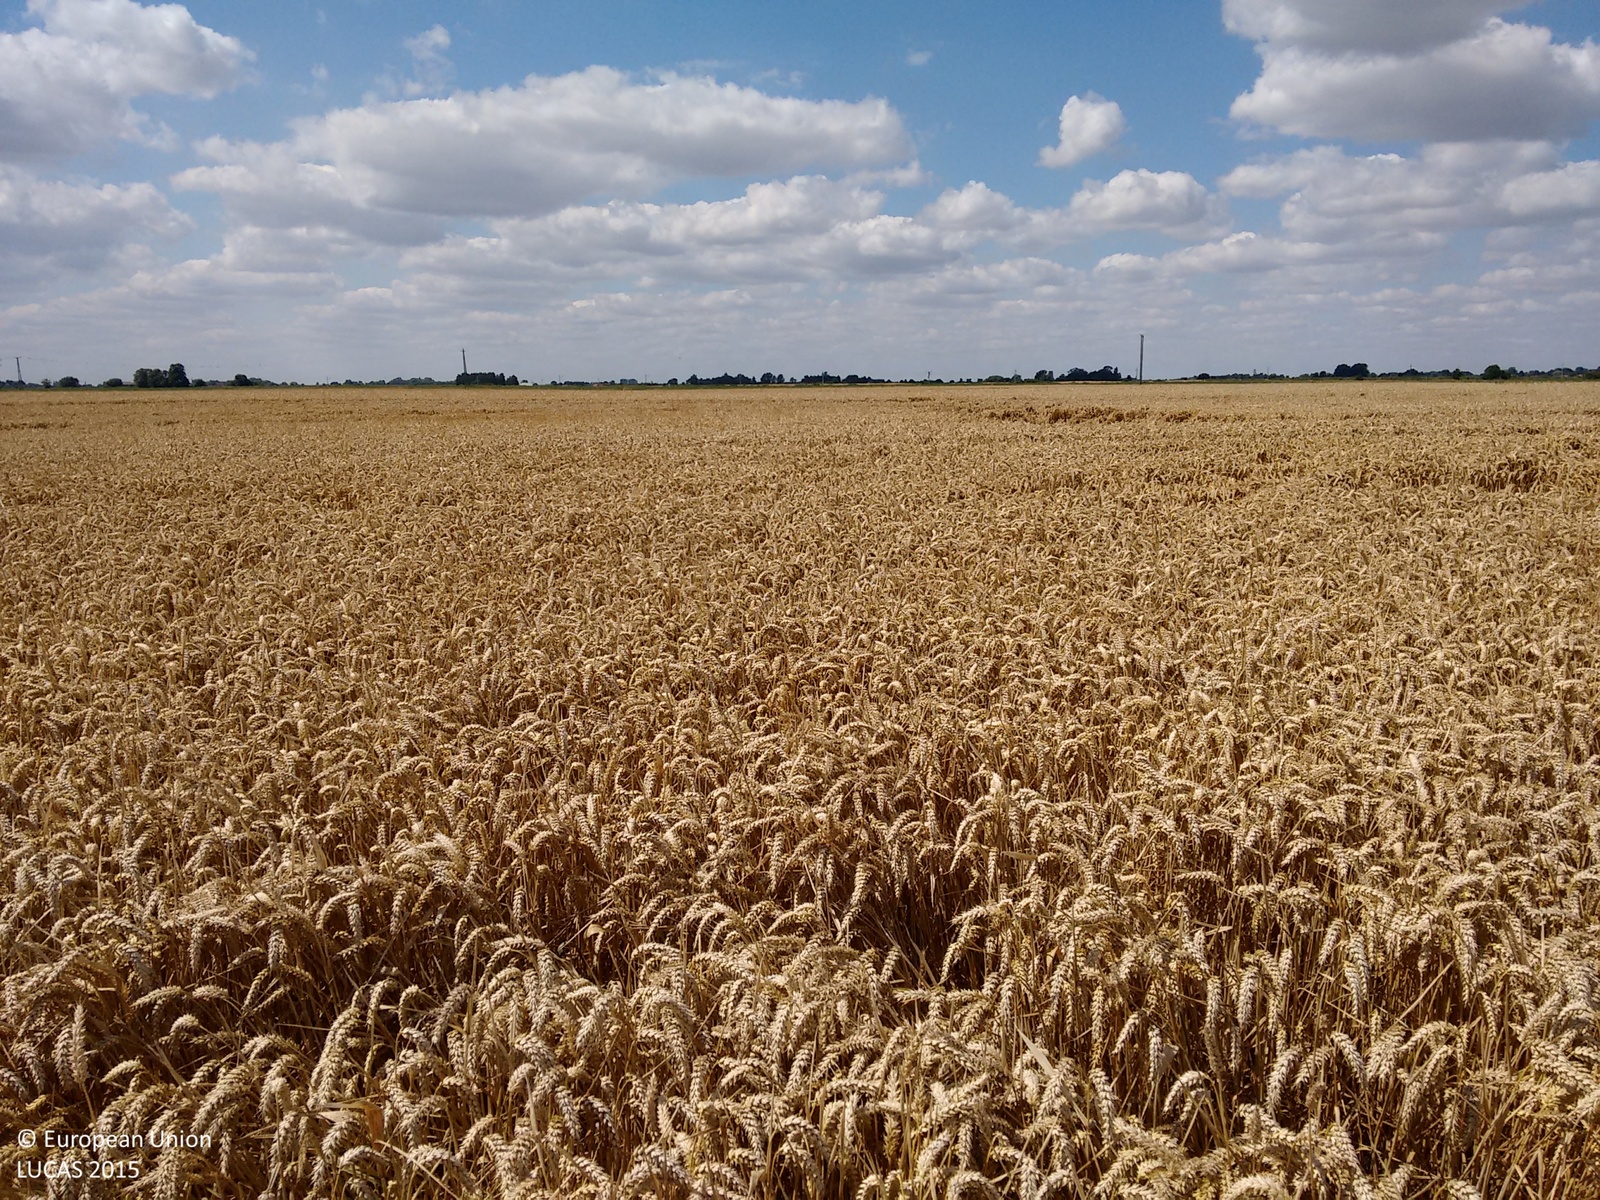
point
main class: Cropland
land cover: Common wheat
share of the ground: > 75 %
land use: Agriculture (excluding fallow land and kitchen gardens)
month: July
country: GB
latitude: 52.6937
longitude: 0.3986
